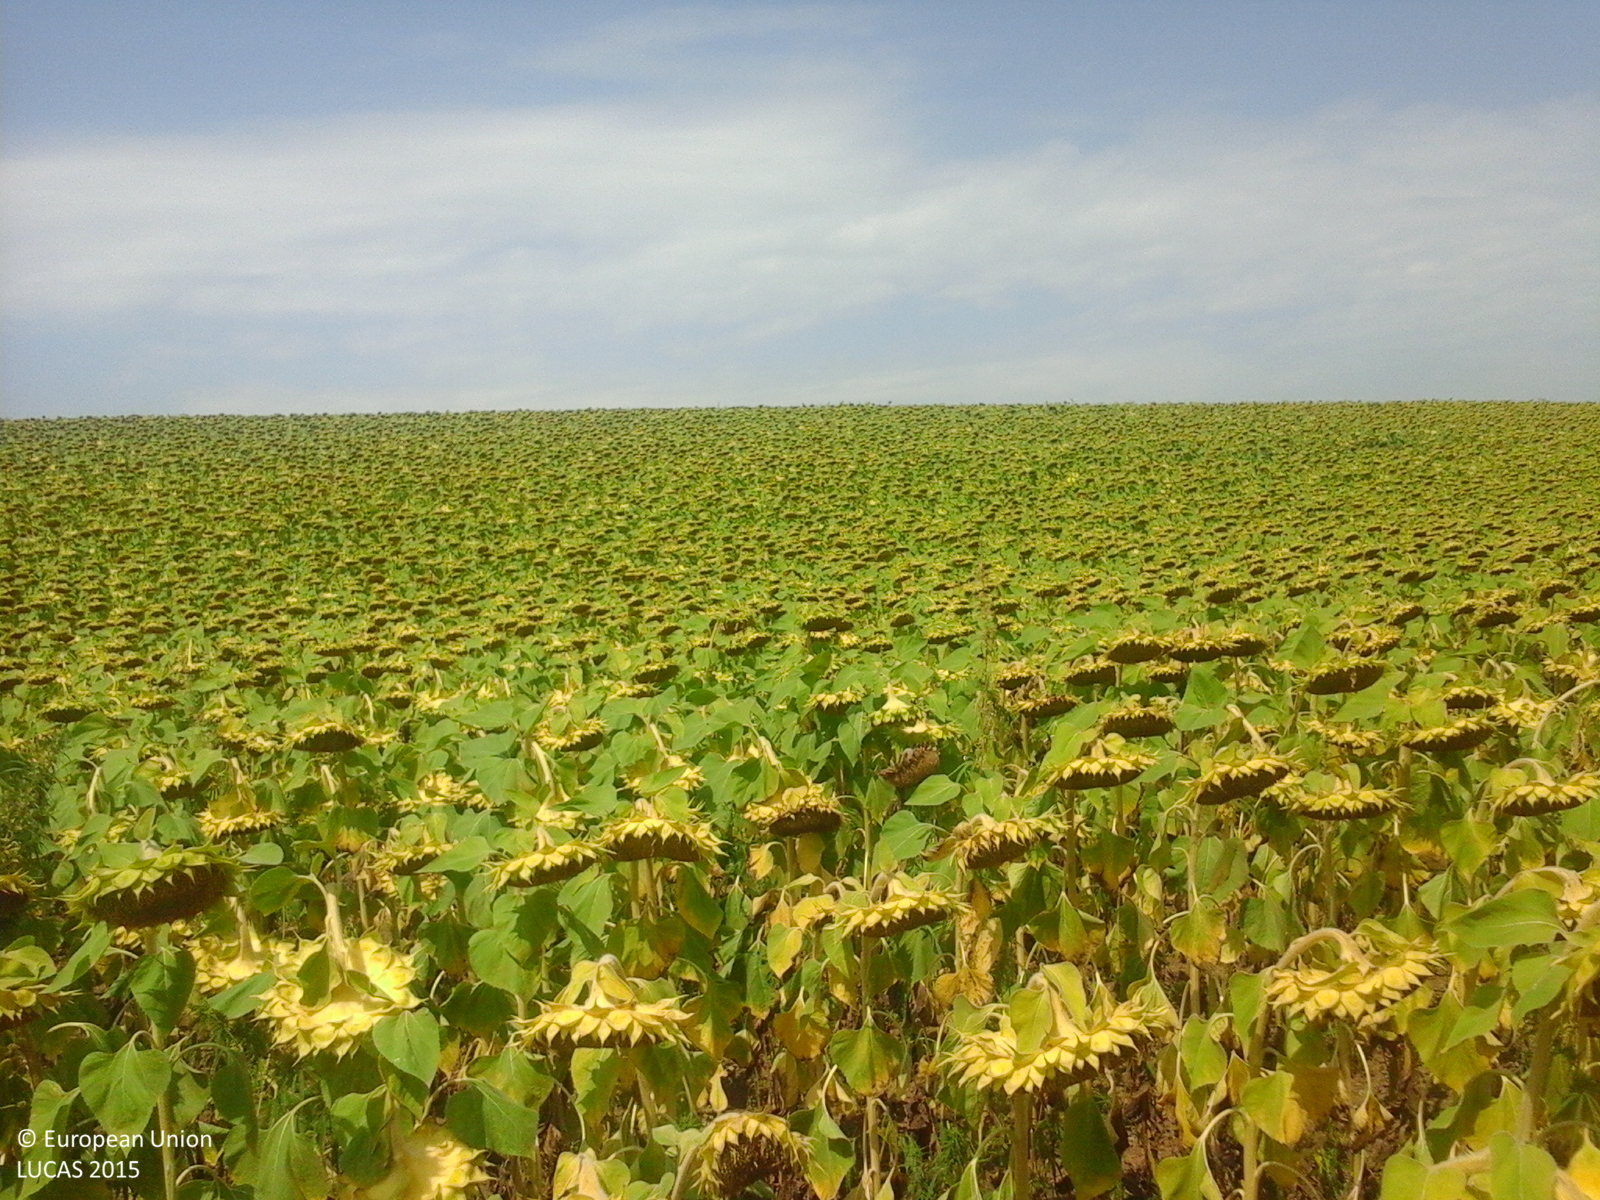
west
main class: Cropland
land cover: Sunflower
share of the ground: > 75 %
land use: Agriculture (excluding fallow land and kitchen gardens)
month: August
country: RO
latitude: 44.0005
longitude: 27.7664
